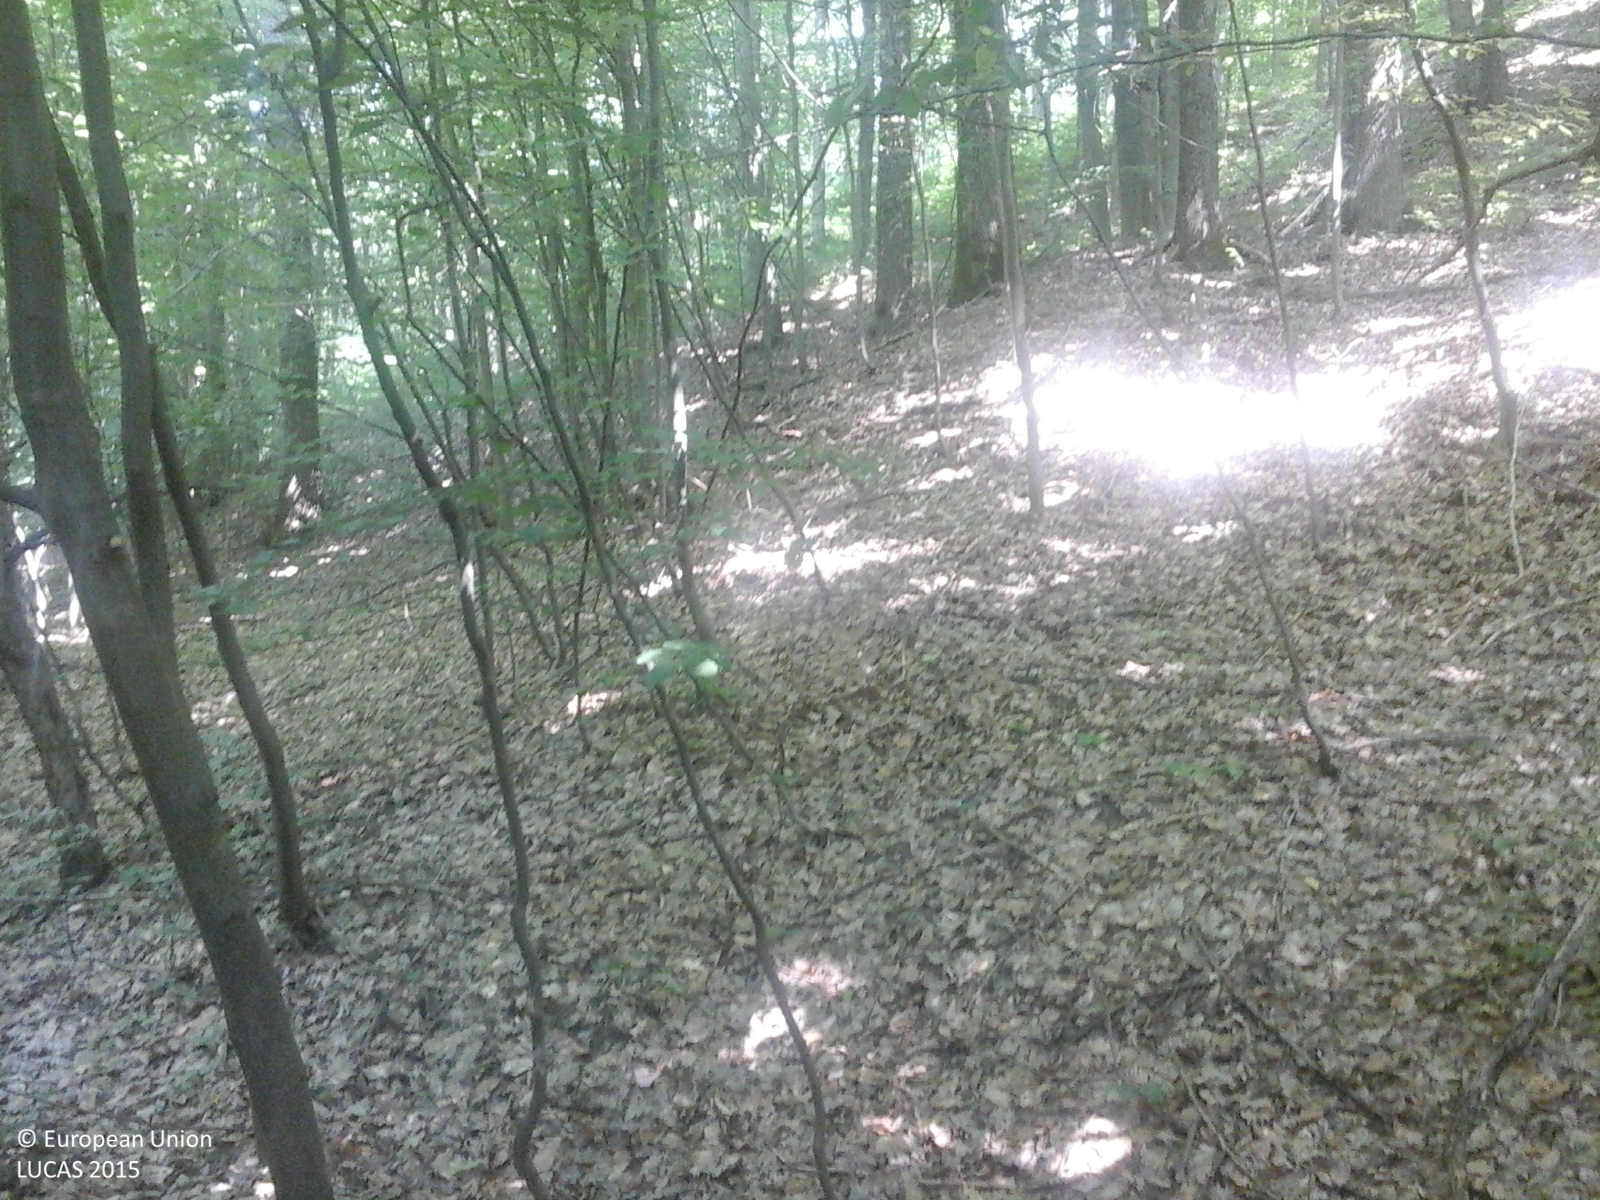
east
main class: Woodland
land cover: Broadleaved woodland
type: mesophytic deciduous forest
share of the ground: > 75 %
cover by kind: broadleaved forest trees 100 %
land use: Forestry
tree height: > 5 m
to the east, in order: Broadleaved woodland
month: July
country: RO
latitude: 44.7728
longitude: 24.7488
